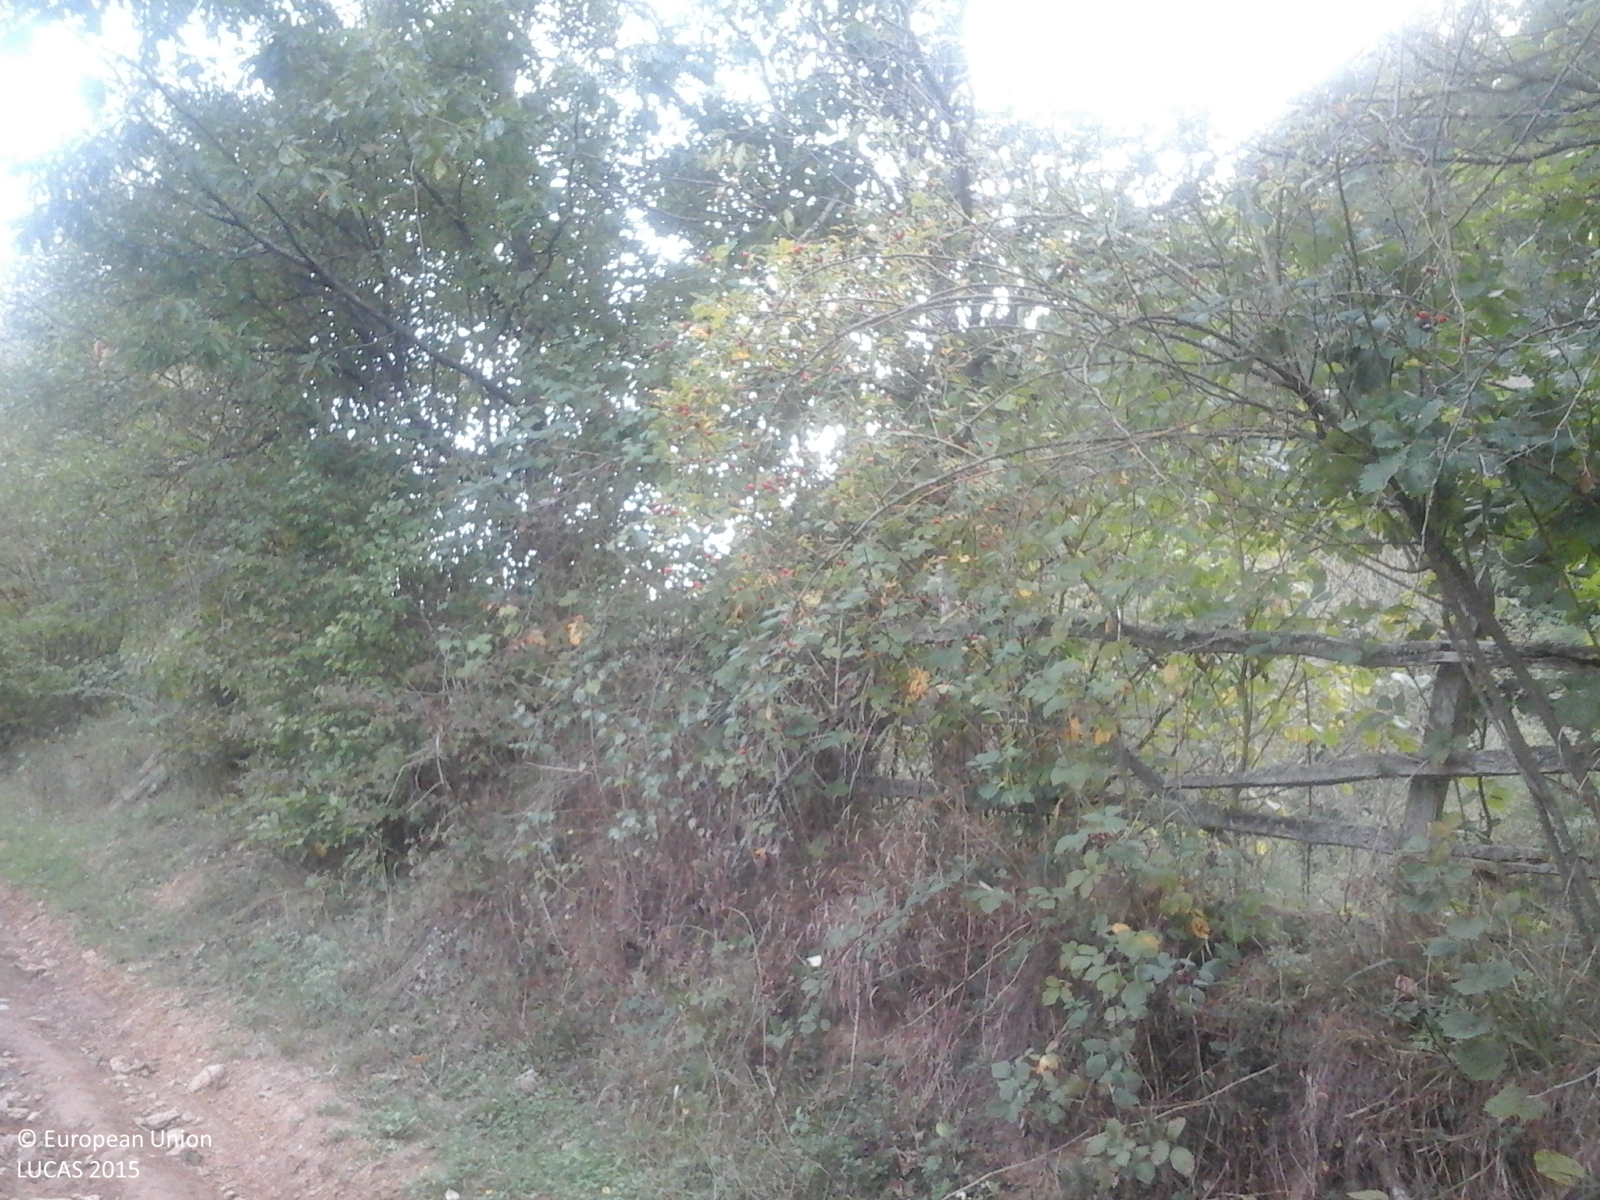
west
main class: Woodland
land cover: Broadleaved woodland
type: acidophilous oak and oak-birch forest
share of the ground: > 75 %
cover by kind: broadleaved forest trees 100 %
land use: Forestry
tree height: > 5 m
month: September
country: RO
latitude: 45.7925
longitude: 22.3825
